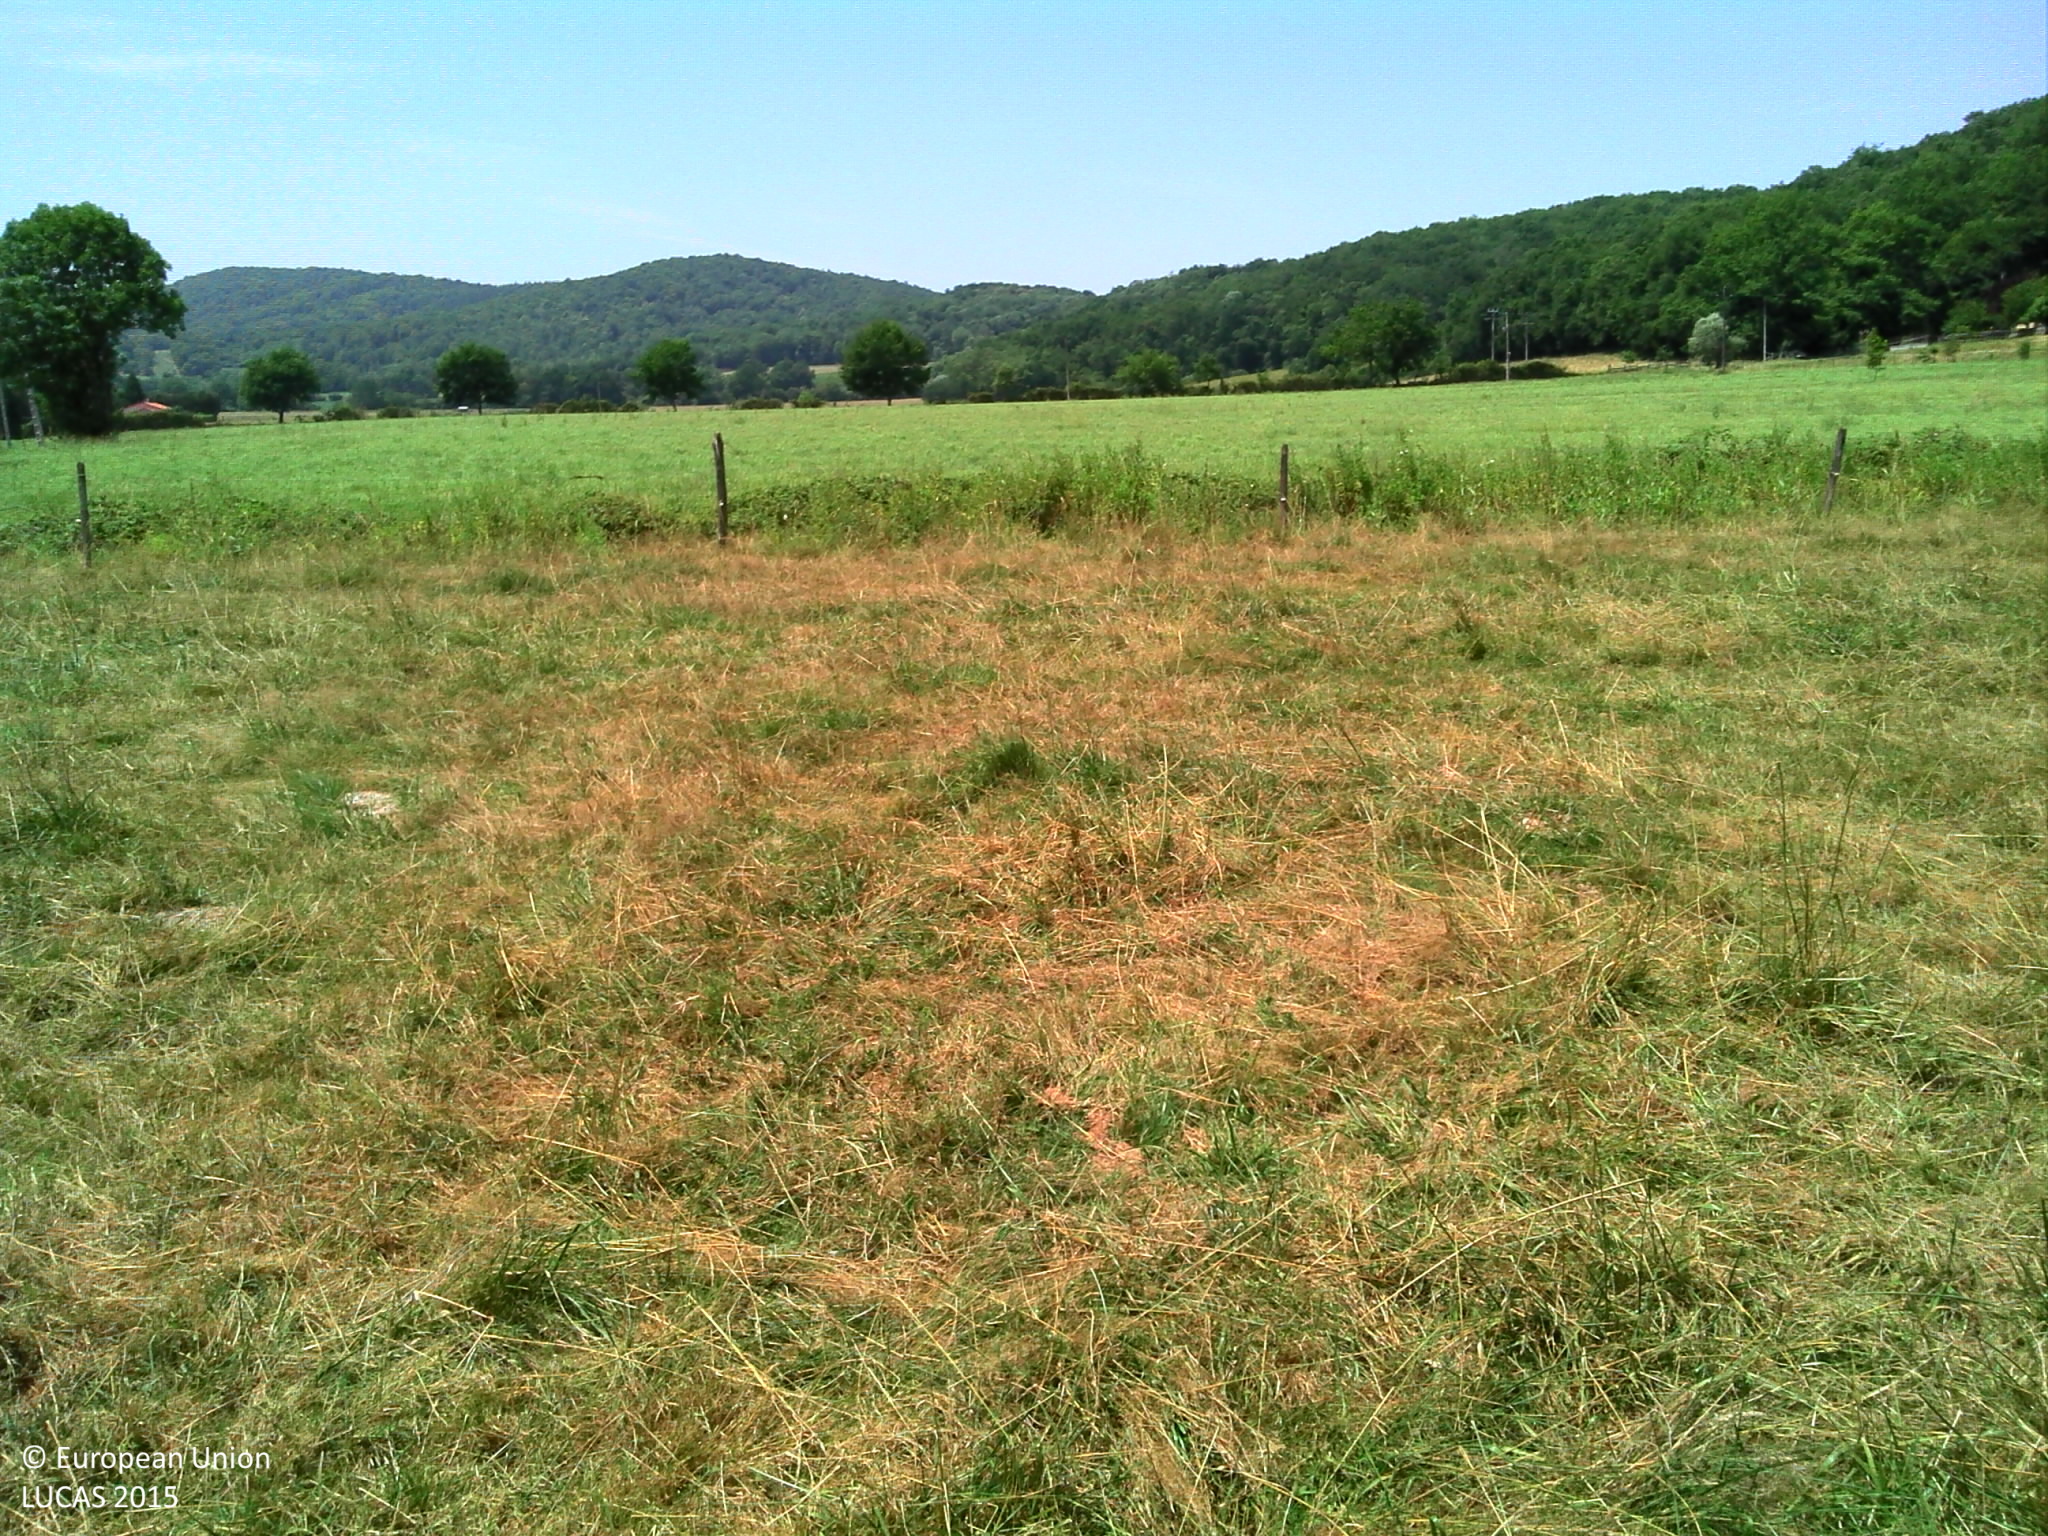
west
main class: Grassland
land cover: Grassland without tree/shrub cover
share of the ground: > 75 %
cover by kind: herbaceous plants 100 %
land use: Agriculture (excluding fallow land and kitchen gardens)
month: July
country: FR
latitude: 43.0860
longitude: 0.7771
